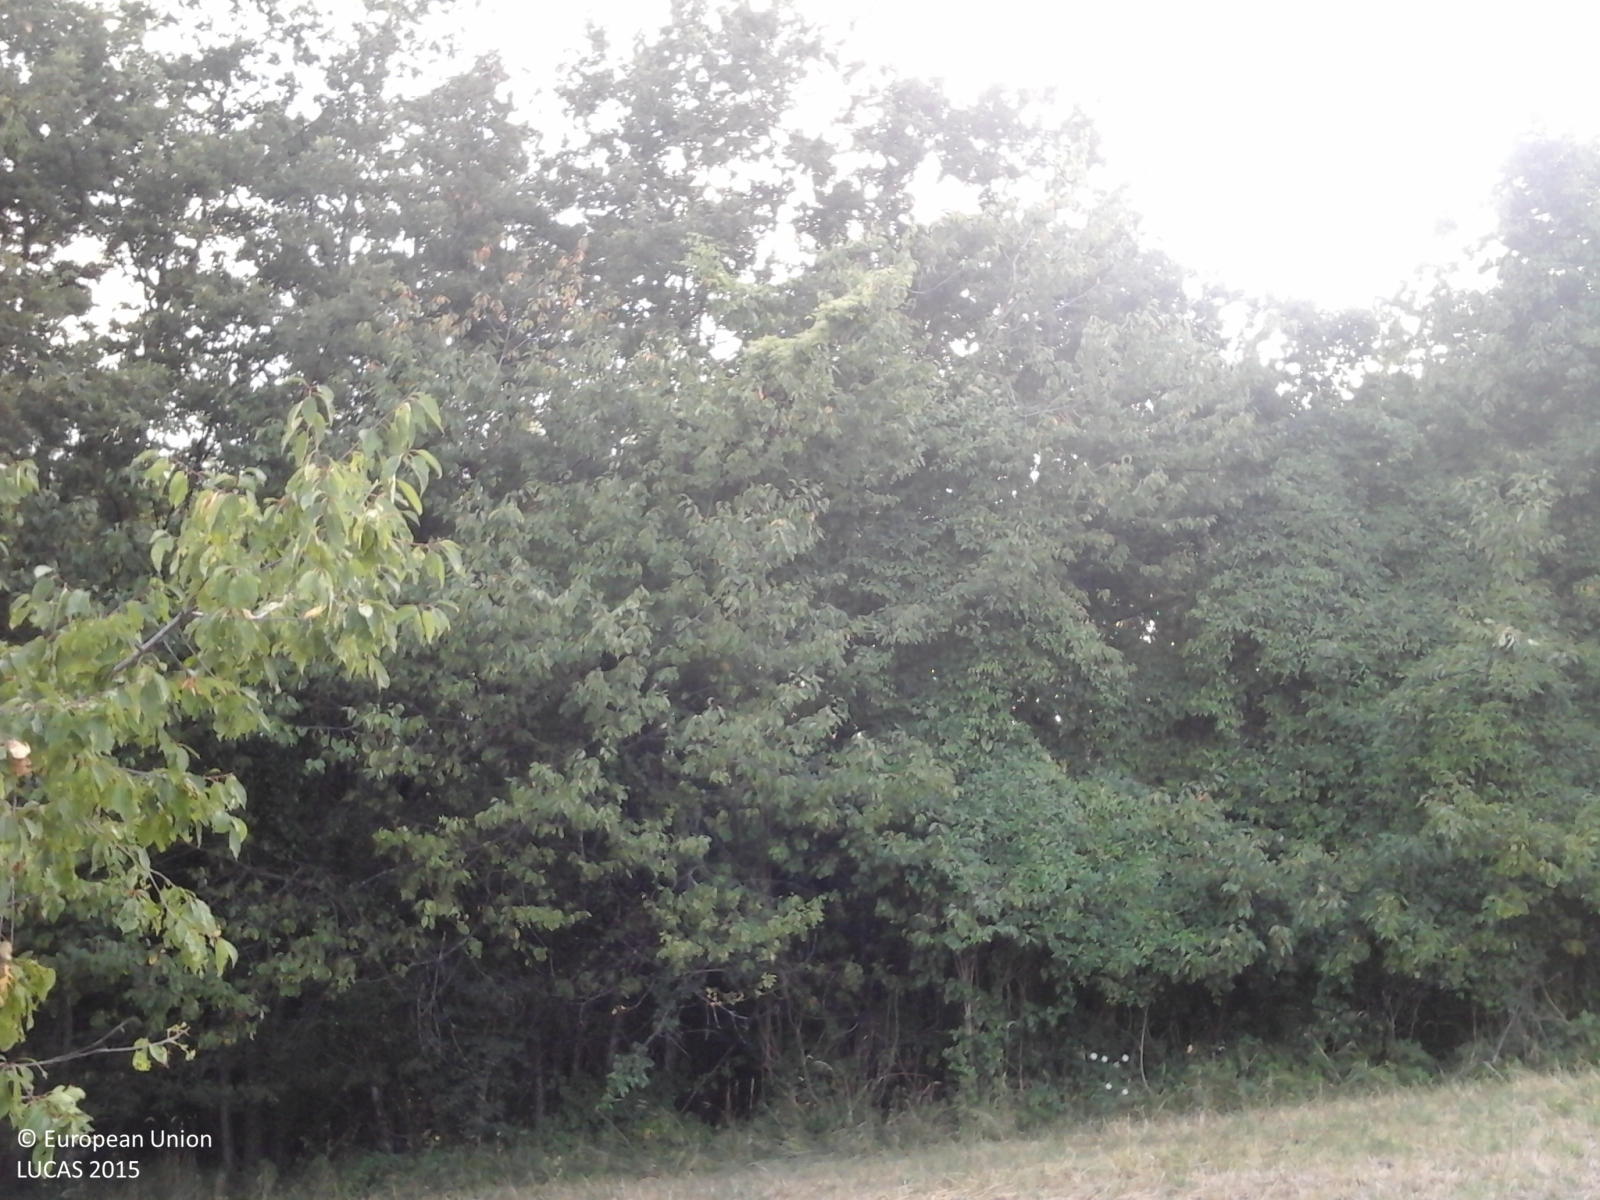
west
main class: Woodland
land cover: Broadleaved woodland
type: thermophilous deciduous forest
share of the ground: > 75 %
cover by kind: broadleaved forest trees 80 %, shrubs 10 %, herbaceous plants 10 %
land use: Forestry
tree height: > 5 m
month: July
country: IT
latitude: 44.2576
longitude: 10.7622
